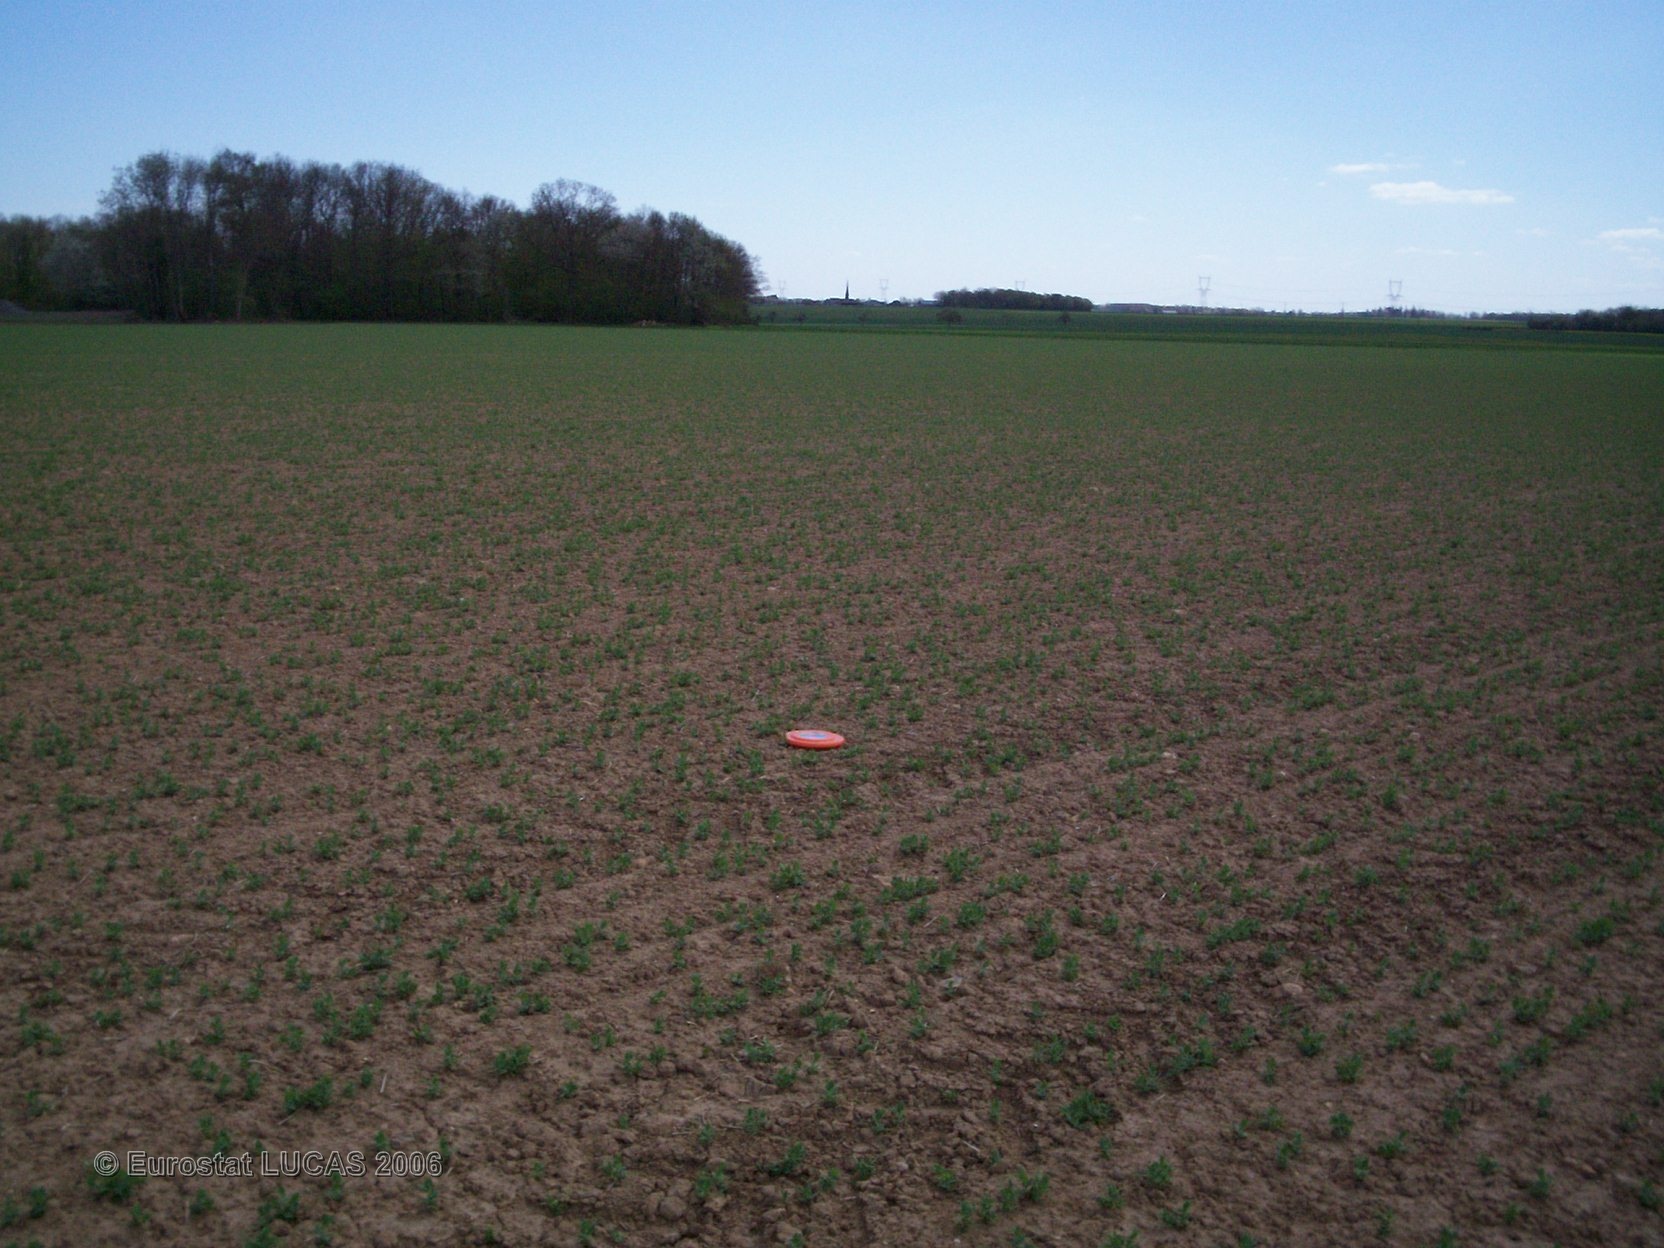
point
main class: Cropland
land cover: Dry pulses
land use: Agriculture (excluding fallow land and kitchen gardens)
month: April
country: FR
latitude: 48.9260
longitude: 1.0390
